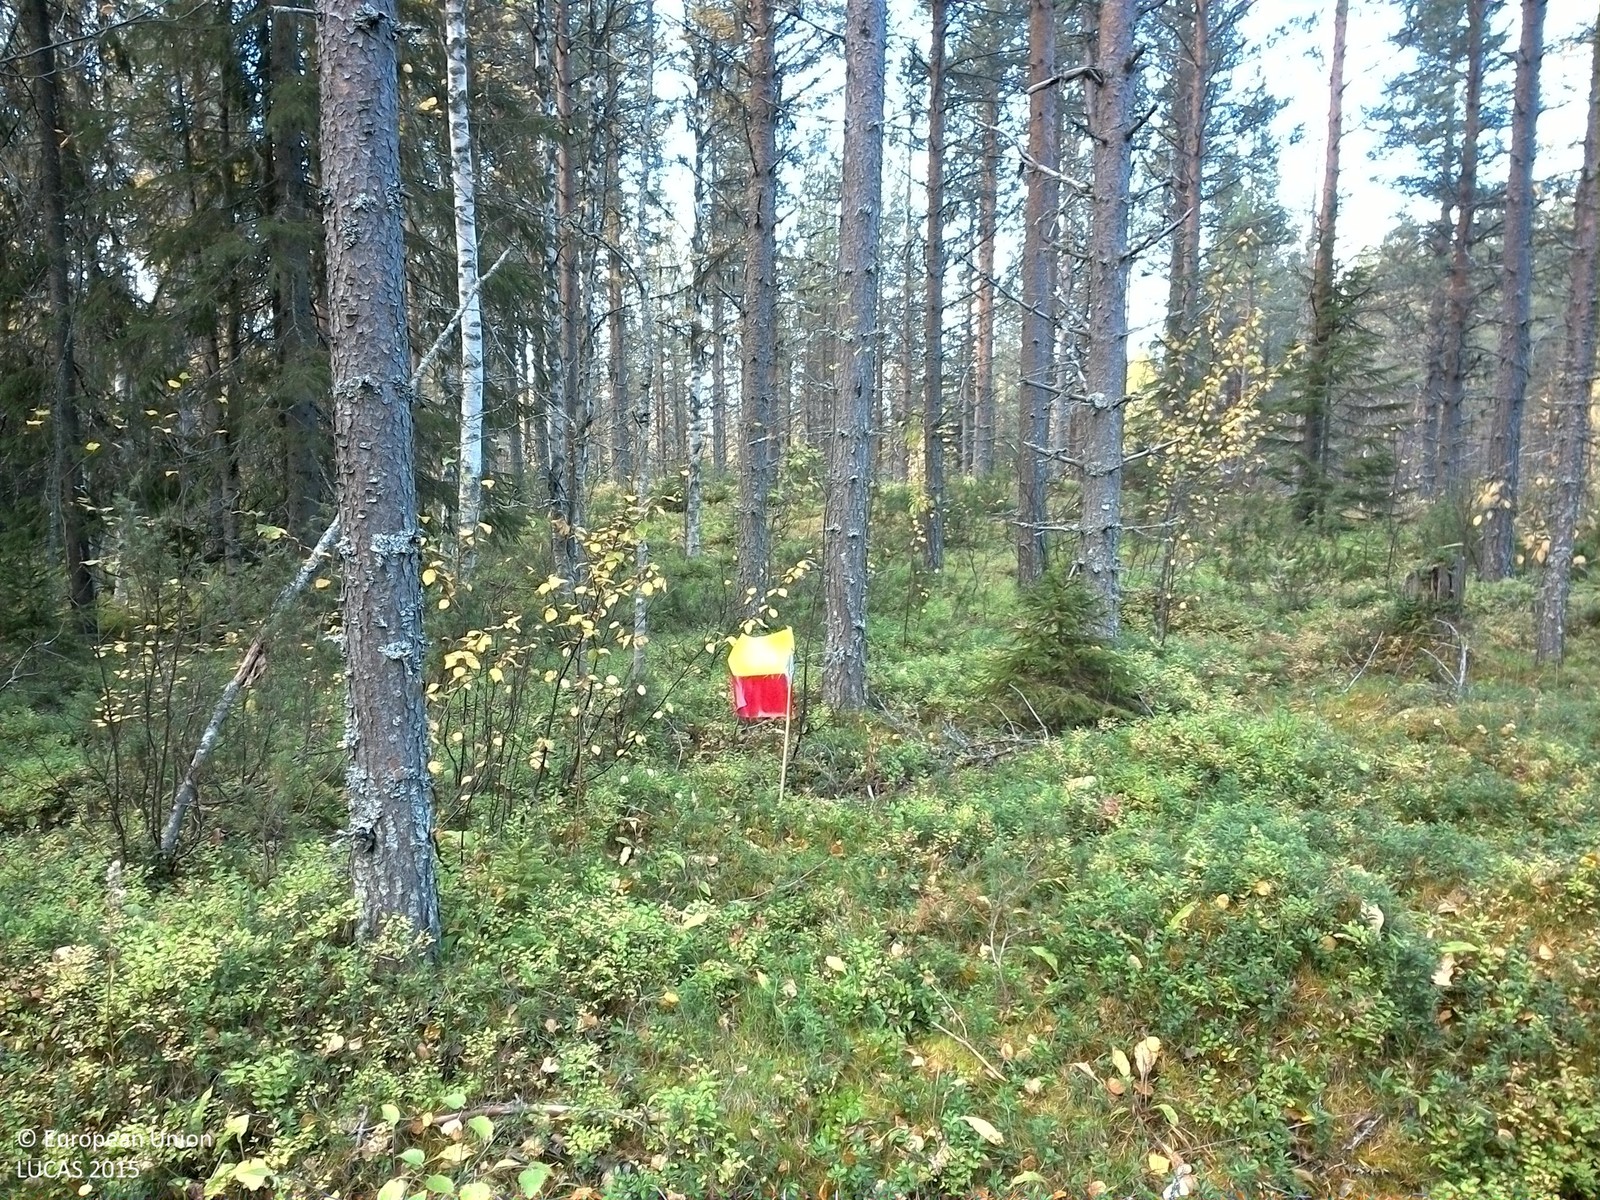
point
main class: Woodland
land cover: Other mixed woodland
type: boreal forest
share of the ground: 50 - 75 %
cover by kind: coniferous forest trees 35 %, shrubs 30 %, broadleaved forest trees 20 %, lichens and mosses 10 %, herbaceous plants 5 %
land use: Forestry
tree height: > 5 m
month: September
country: SE
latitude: 64.2172
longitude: 16.3370
